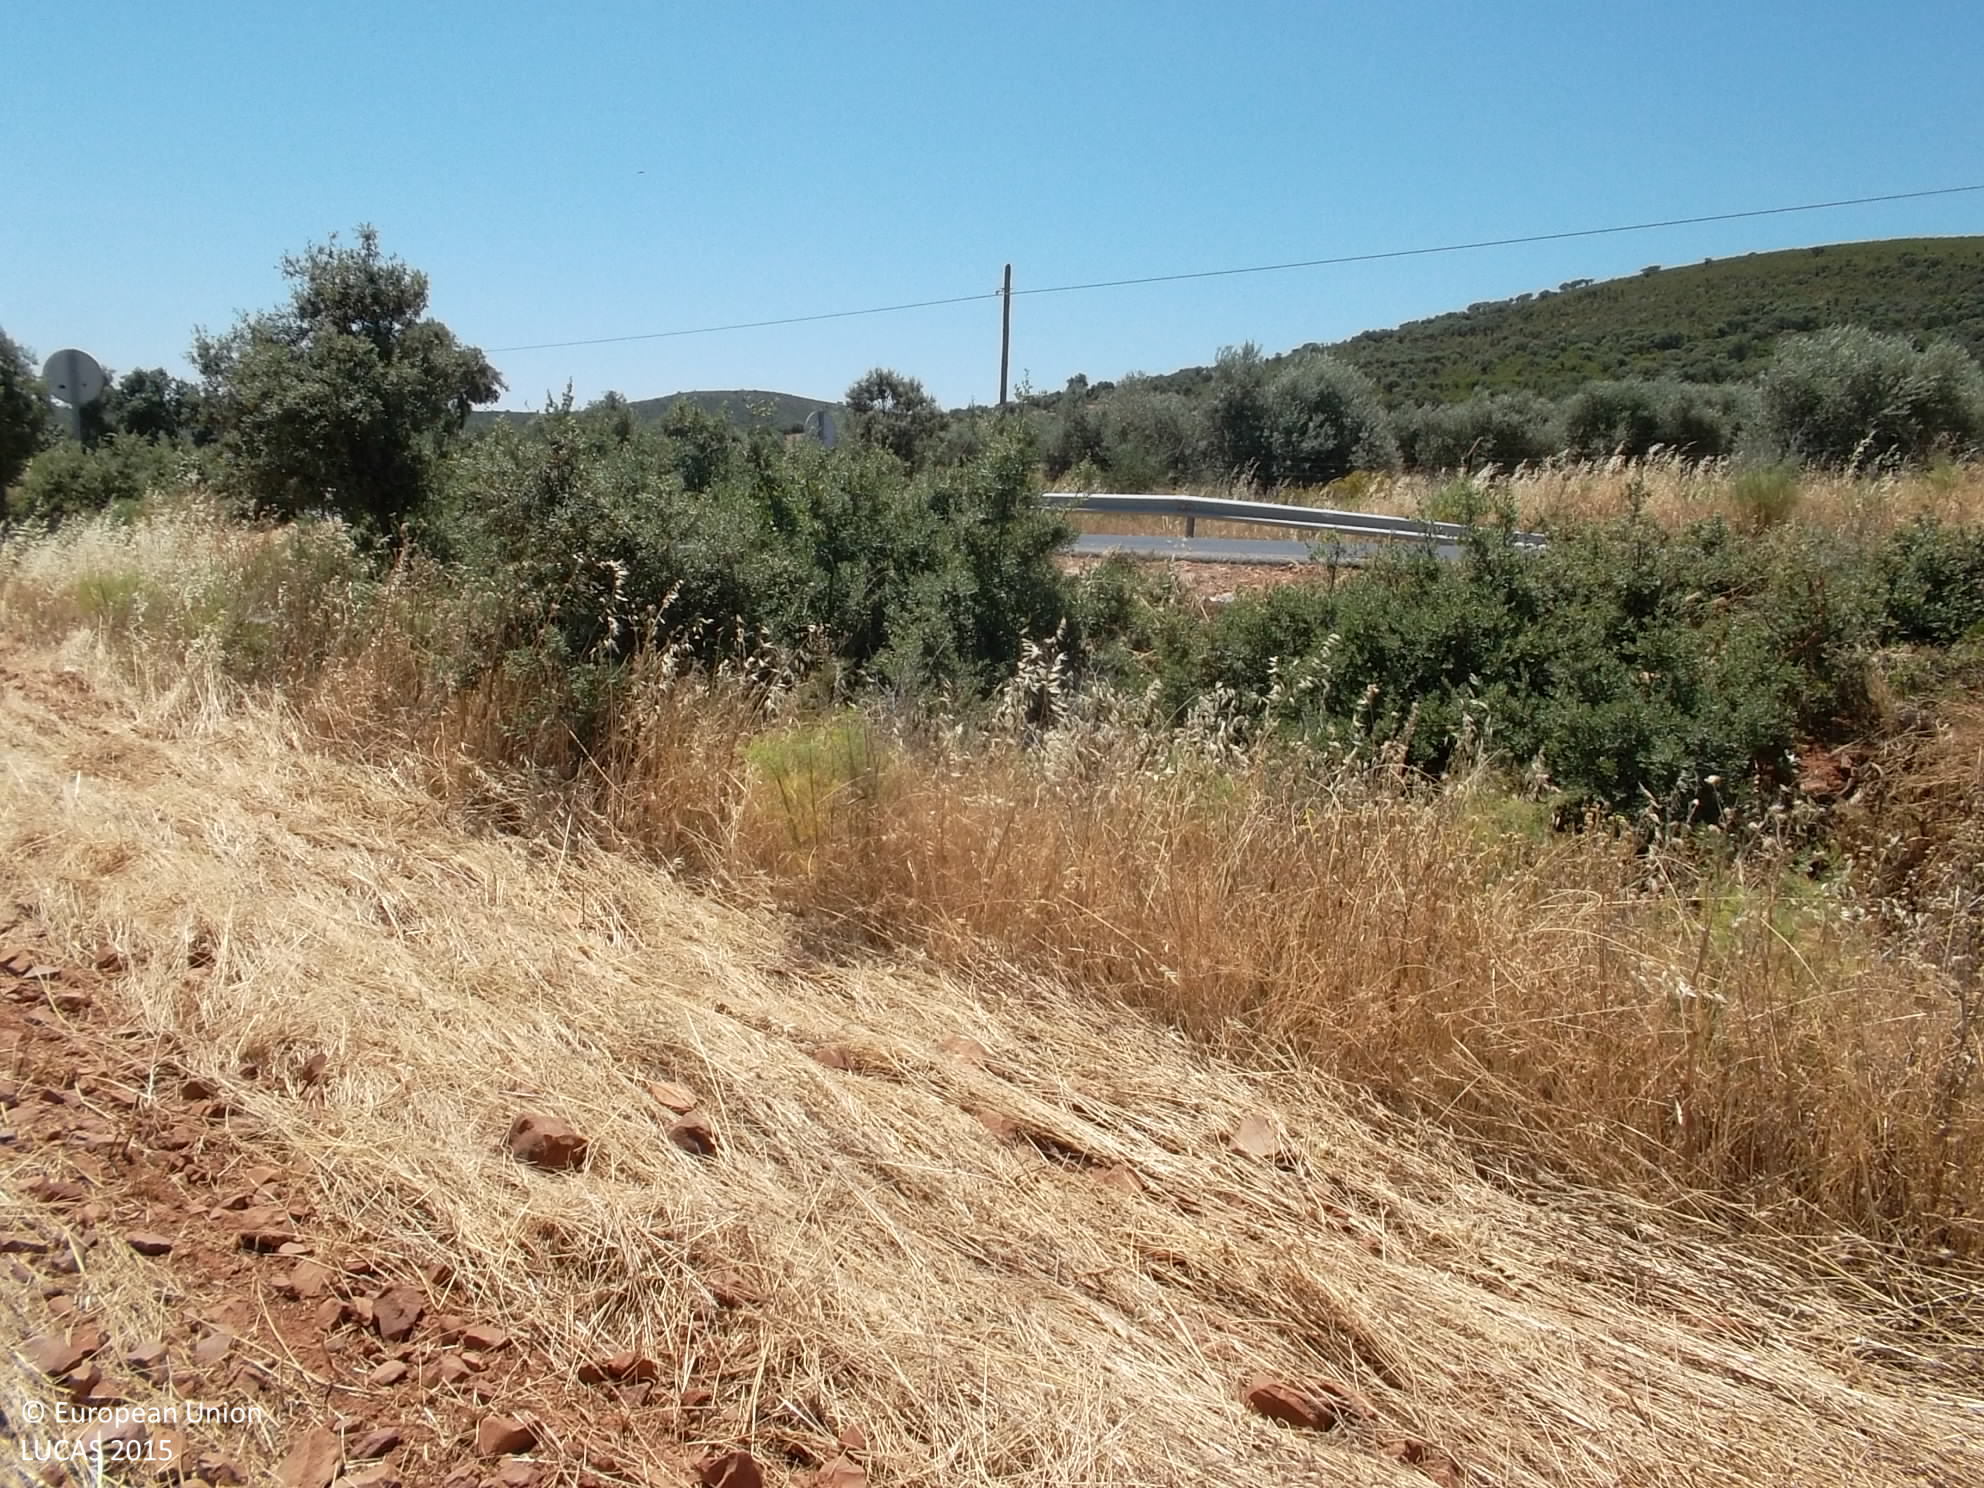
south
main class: Cropland
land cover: Common wheat
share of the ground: > 75 %
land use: Agriculture (excluding fallow land and kitchen gardens)
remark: Harvested field
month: June
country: ES
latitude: 39.0973
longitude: -4.0959
